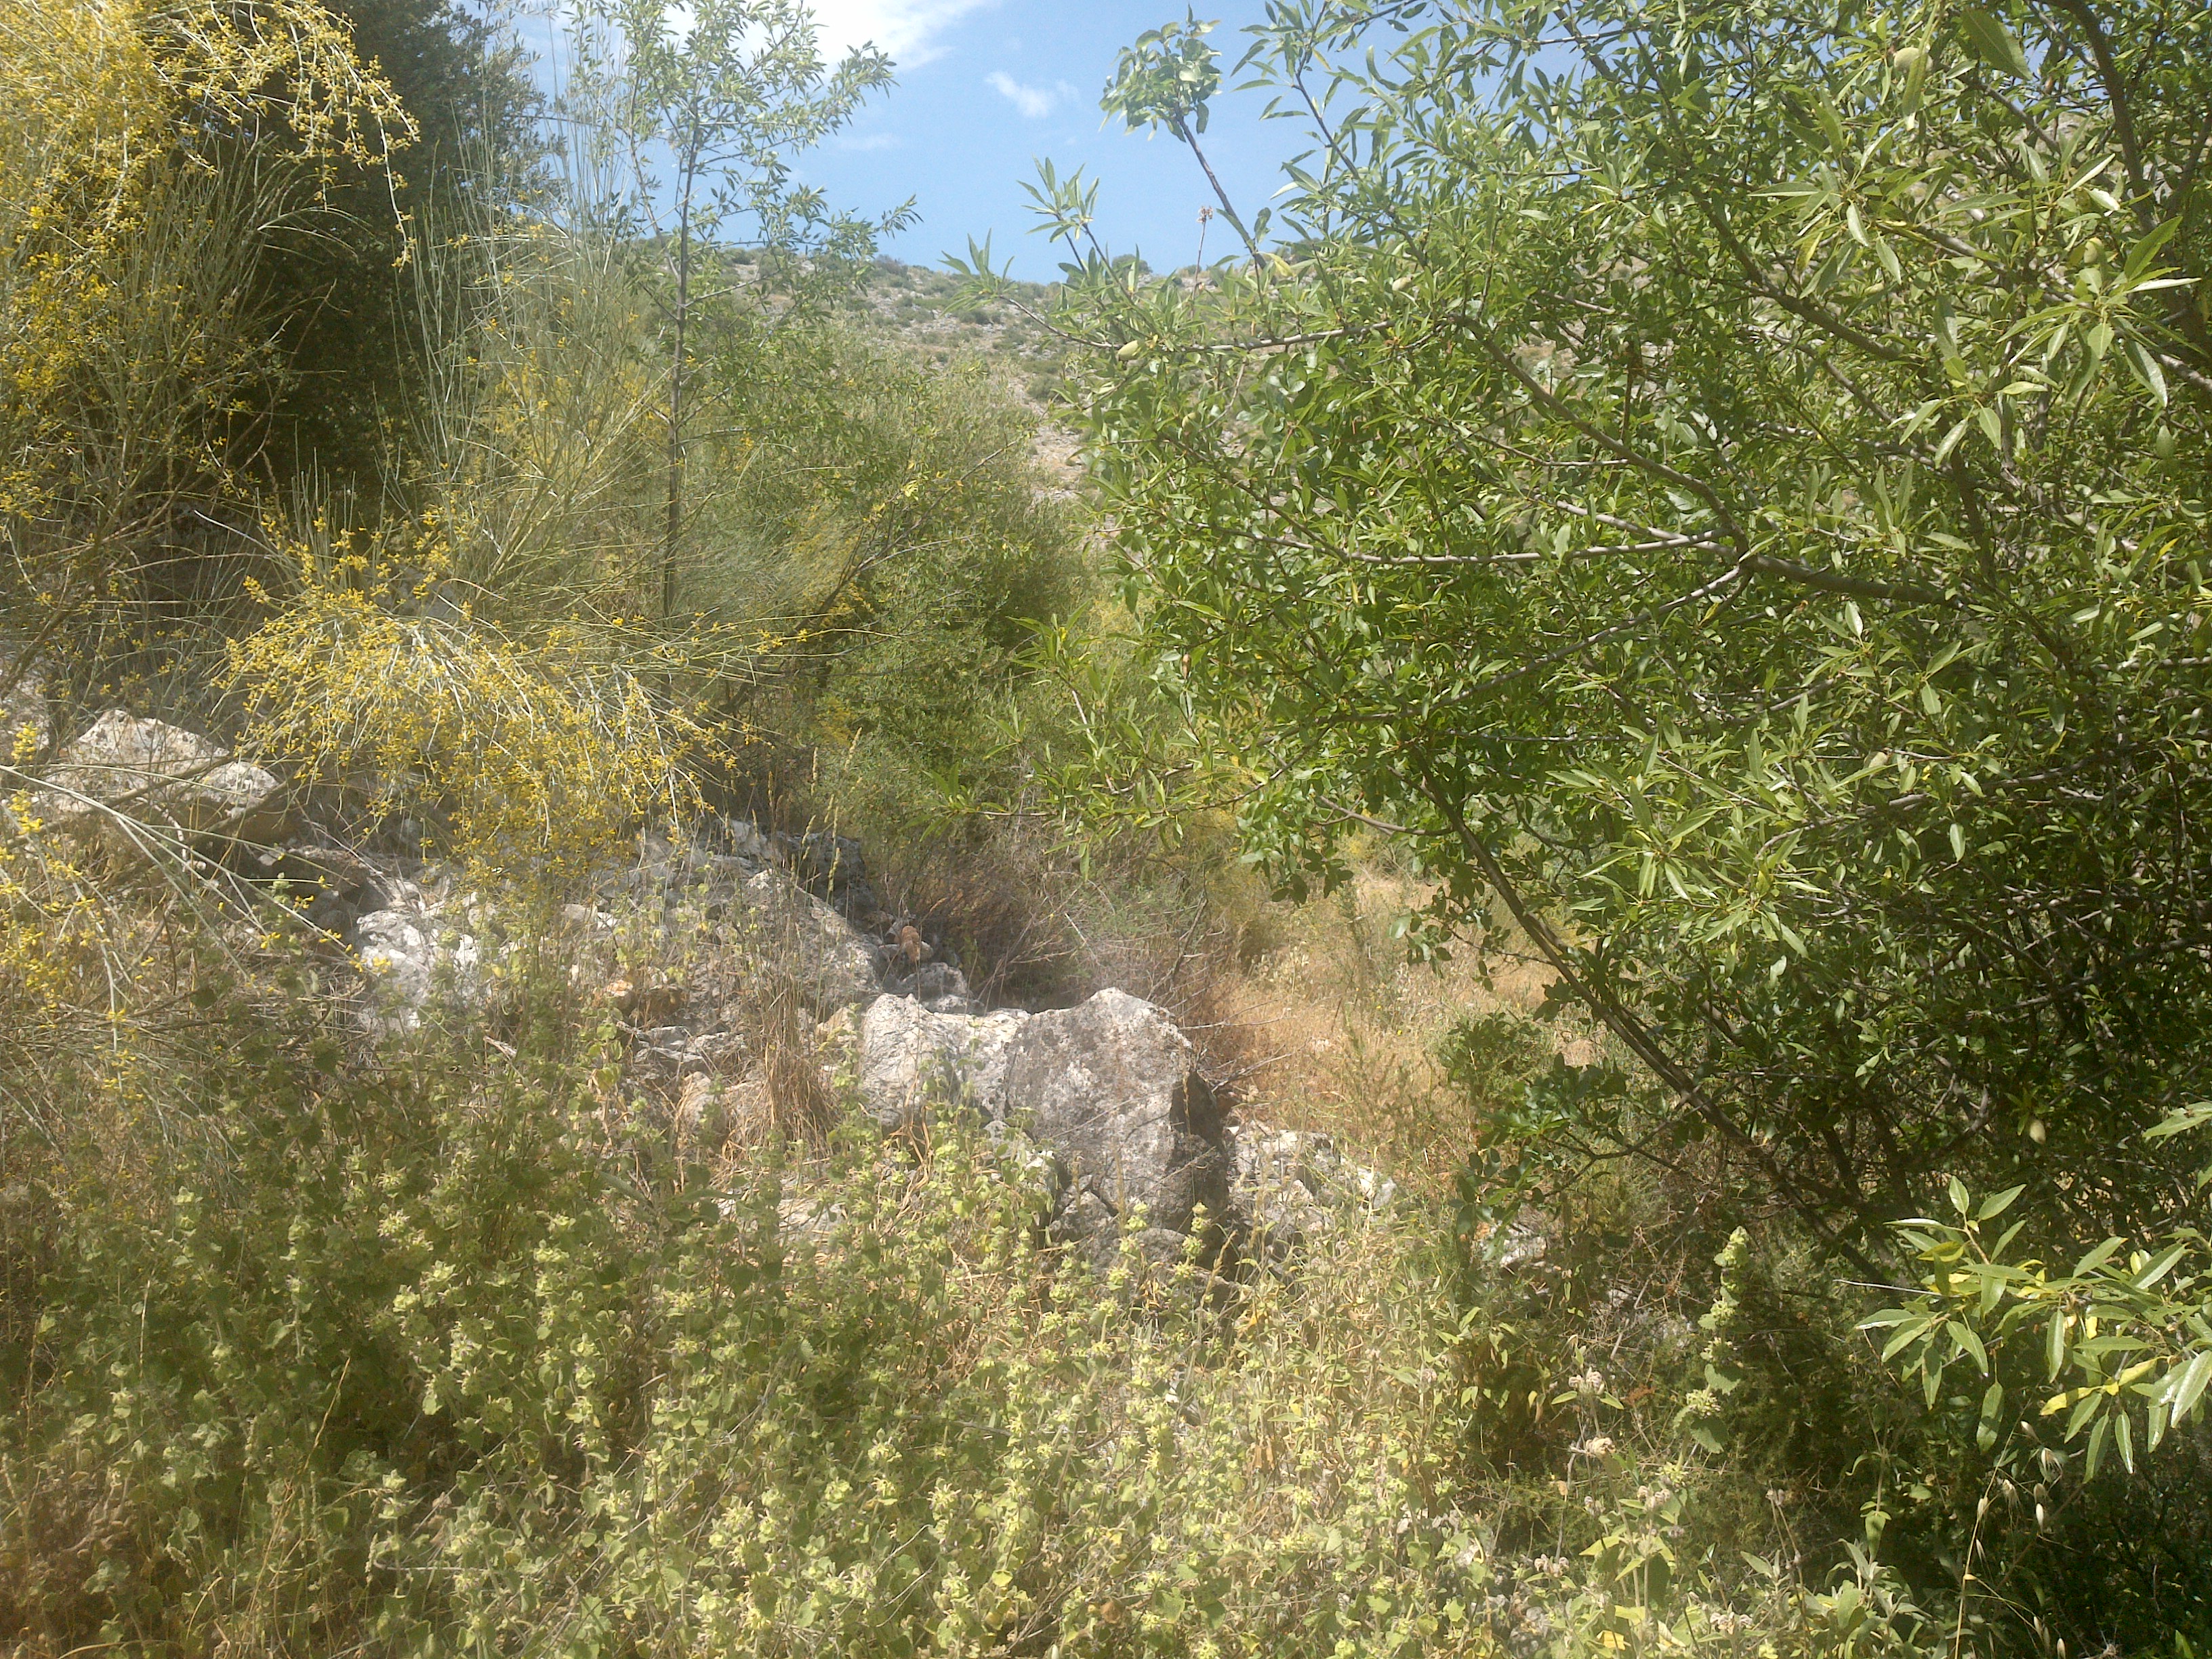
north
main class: Shrubland
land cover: Shrubland with sparse tree cover
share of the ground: 25 - 50 %
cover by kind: herbaceous plants 50 %, shrubs 25 %, unconsolidated bare surface 20 %, broadleaved forest trees 5 %
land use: Semi-natural and natural areas not in use
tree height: < 5 m
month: May
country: ES
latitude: 37.4968
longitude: -4.2418
